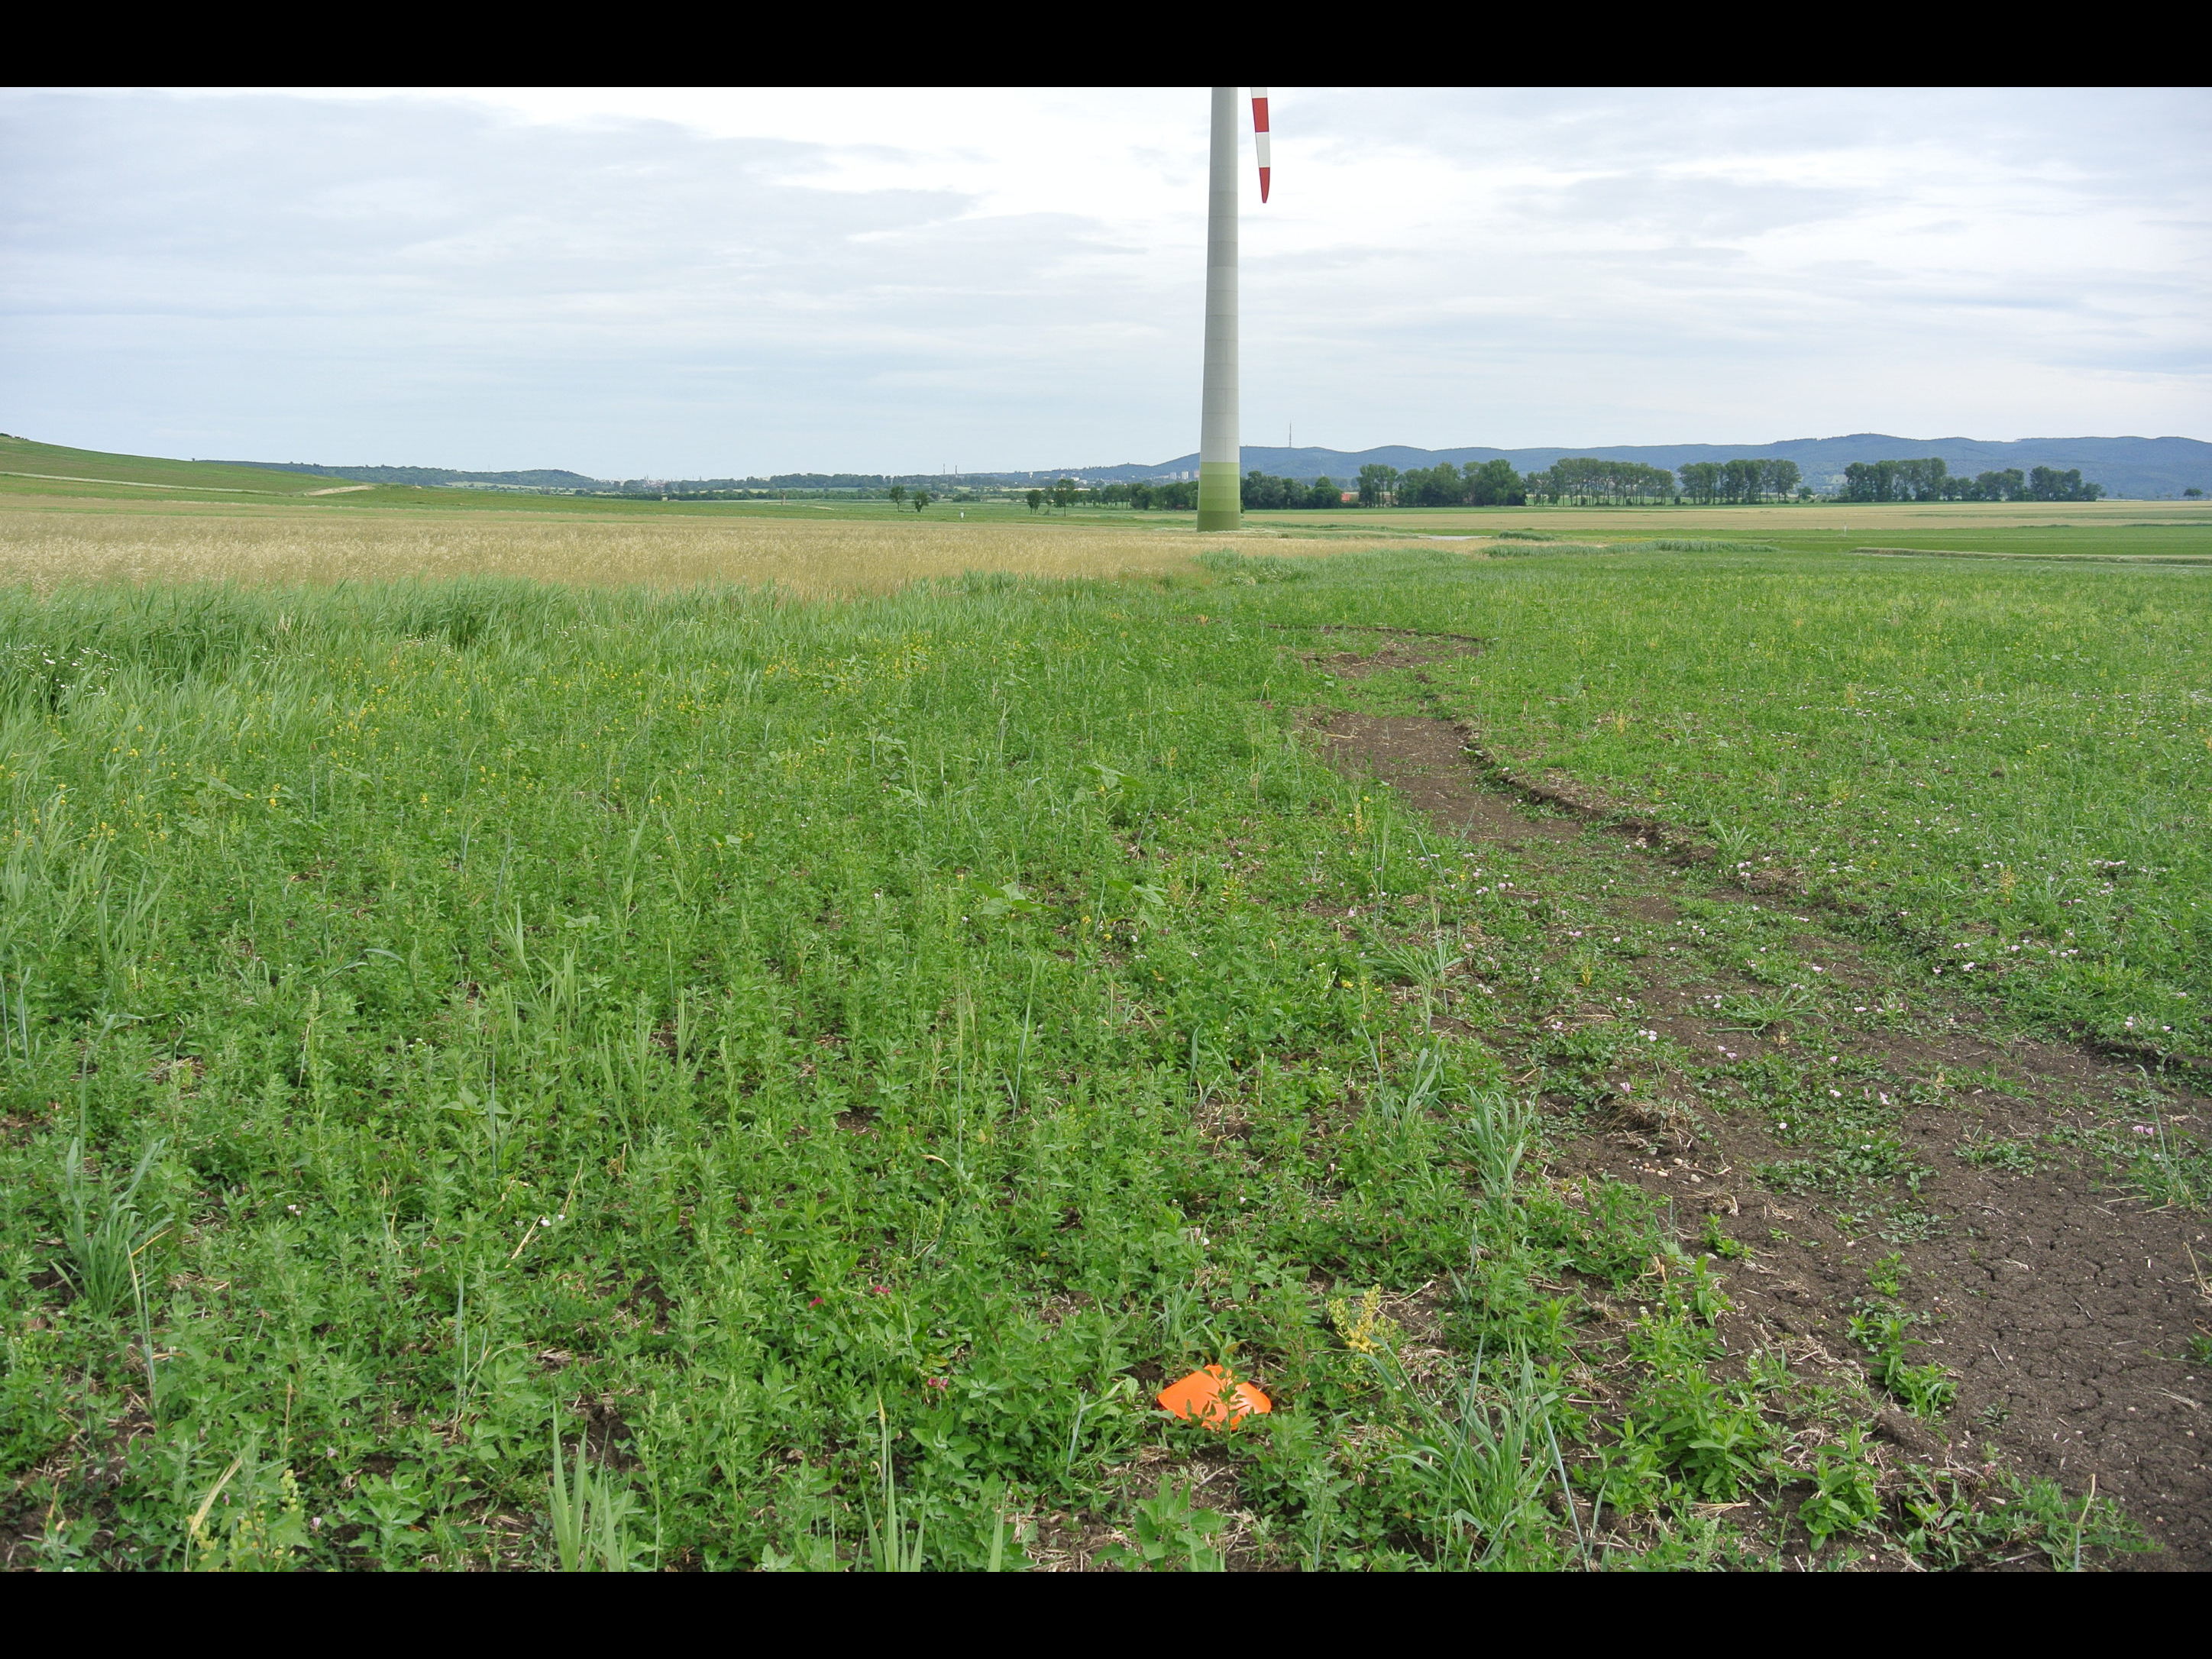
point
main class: Cropland
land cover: Other leguminous and mixtures for fodder
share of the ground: > 75 %
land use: Agriculture (excluding fallow land and kitchen gardens)
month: June
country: AT
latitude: 47.7413
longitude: 16.5259
